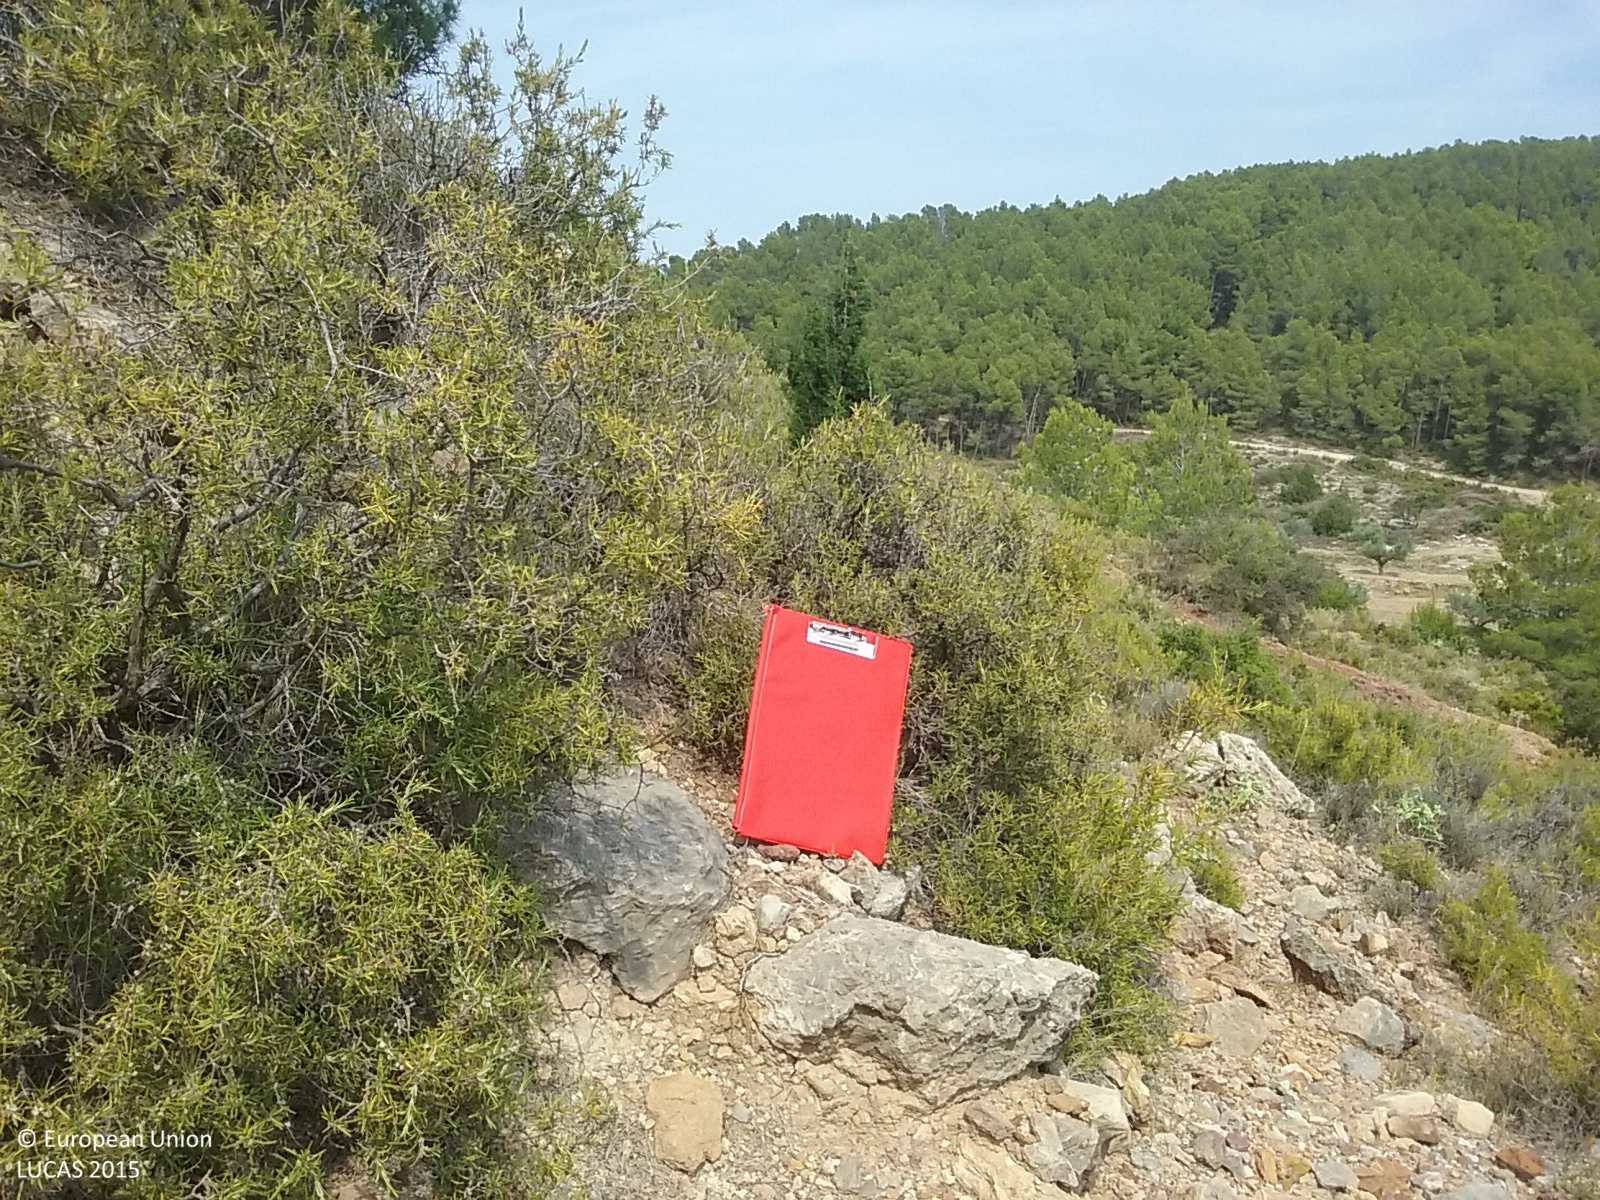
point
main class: Woodland
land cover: Pine dominated coniferous woodland
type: coniferous forest of the mediterranean region
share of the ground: 10 - 25 %
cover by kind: shrubs 40 %, unconsolidated bare surface 40 %, coniferous forest trees 10 %, herbaceous plants 10 %
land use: Semi-natural and natural areas not in use
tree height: < 5 m
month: July
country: ES
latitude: 39.9217
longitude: -0.6621
